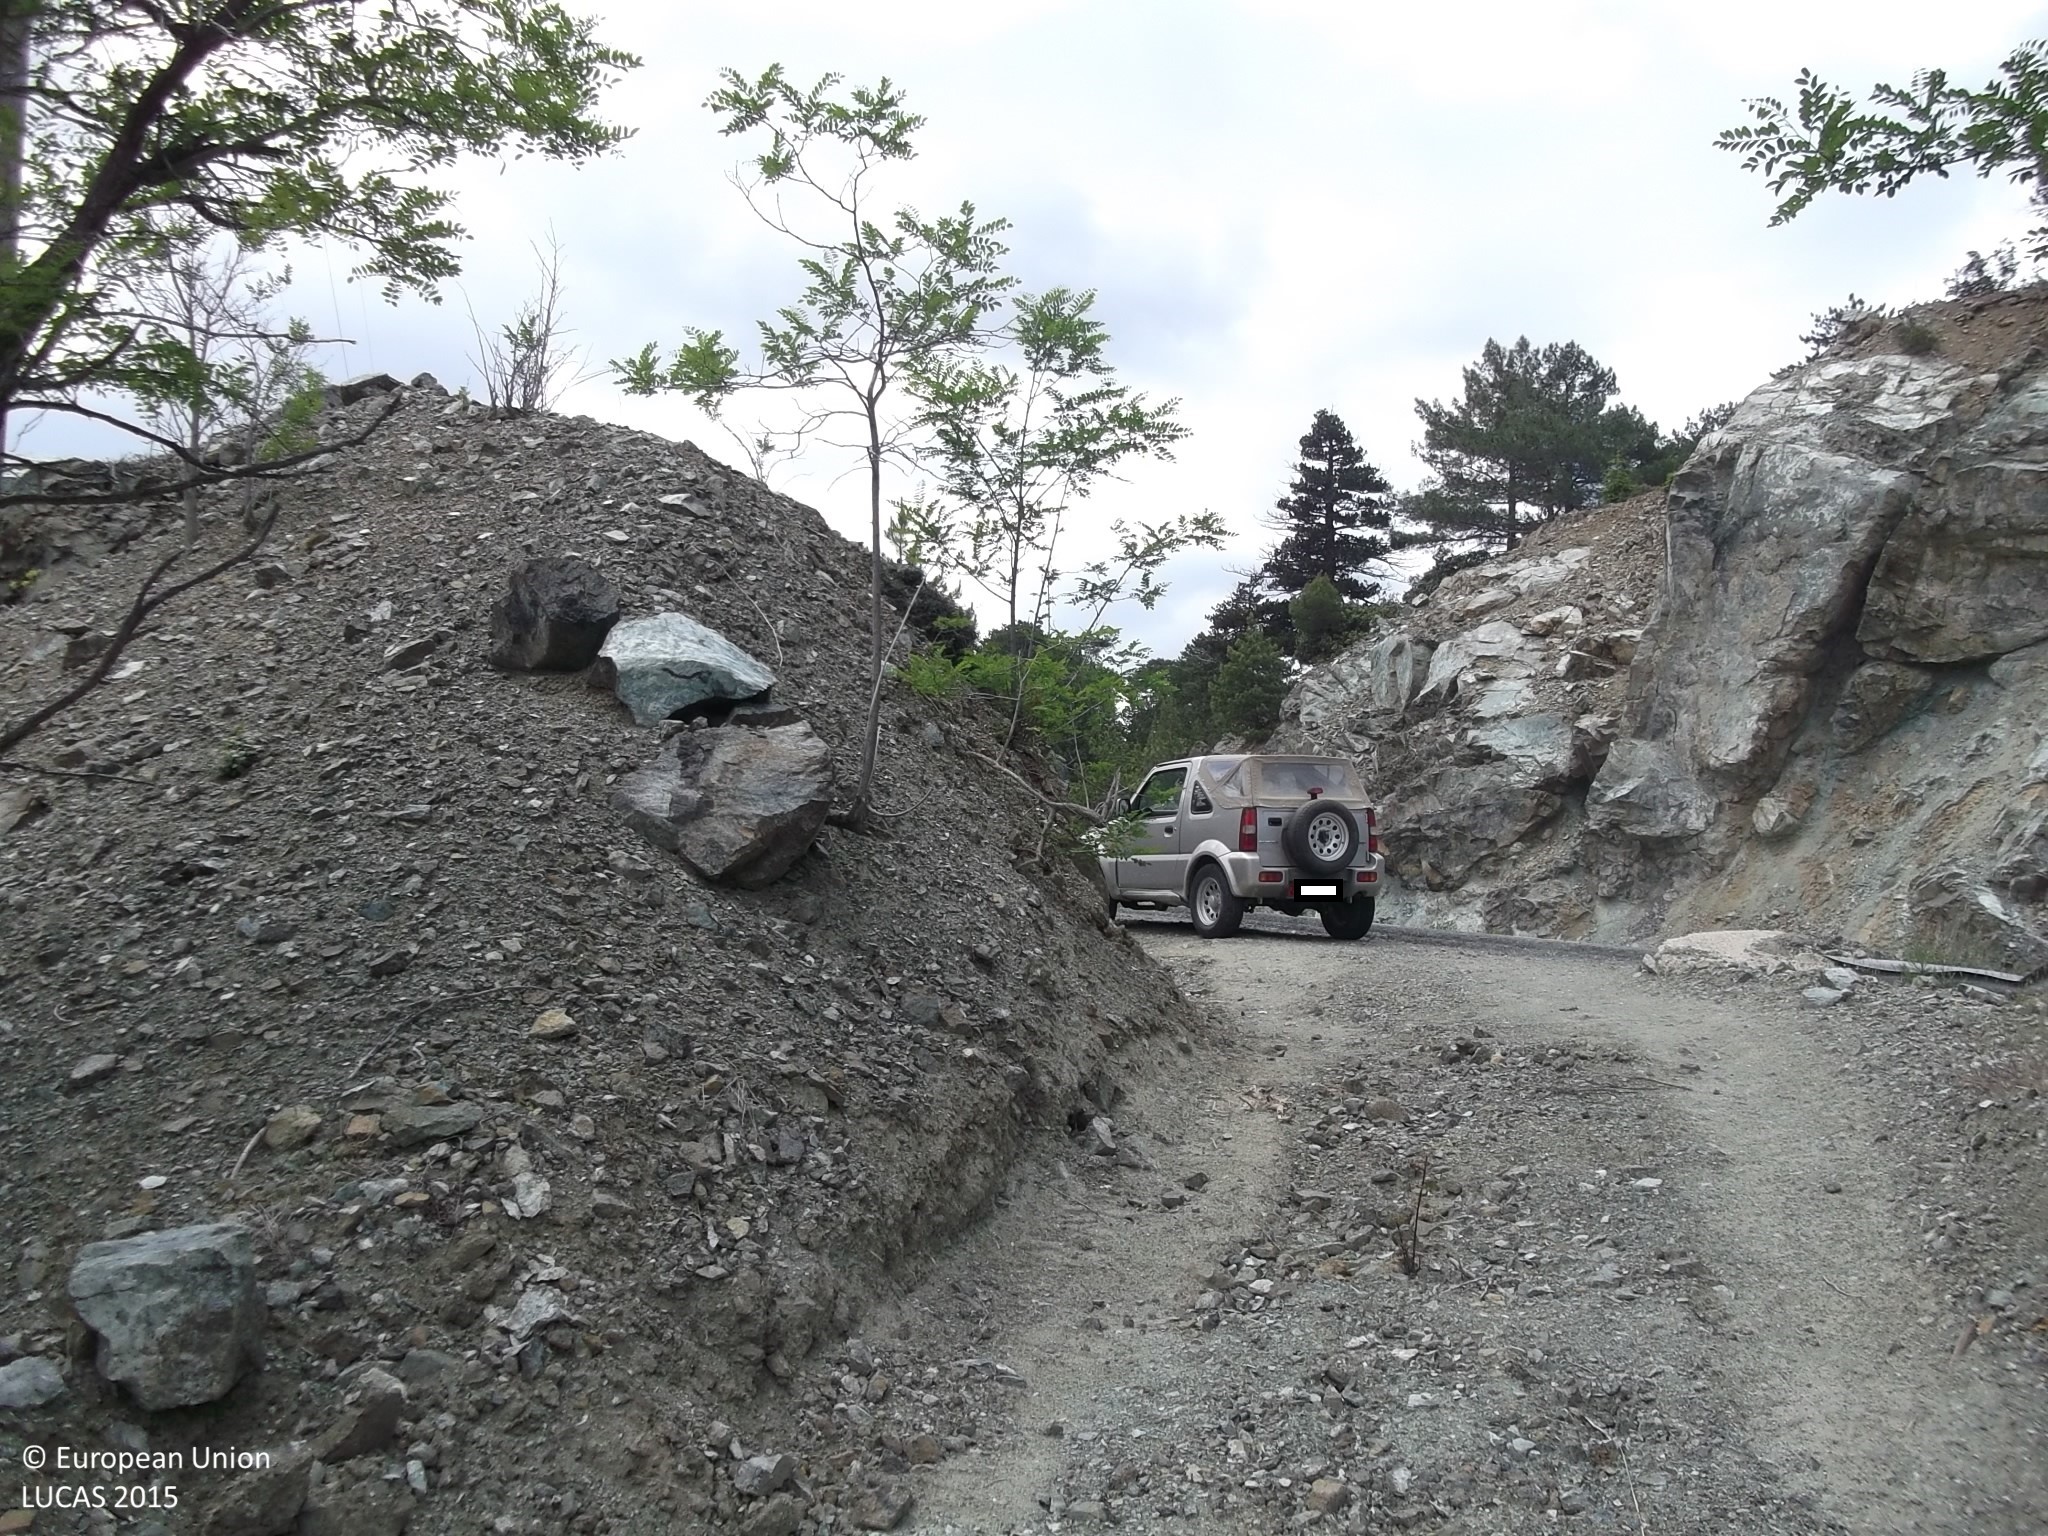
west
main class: Woodland
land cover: Pine dominated coniferous woodland
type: coniferous forest of the mediterranean region
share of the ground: 10 - 25 %
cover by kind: consolidated bare surface 35 %, unconsolidated bare surface 25 %, coniferous forest trees 20 %, shrubs 20 %
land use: Forestry
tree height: > 5 m
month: June
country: CY
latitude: 34.9305
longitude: 32.9059
